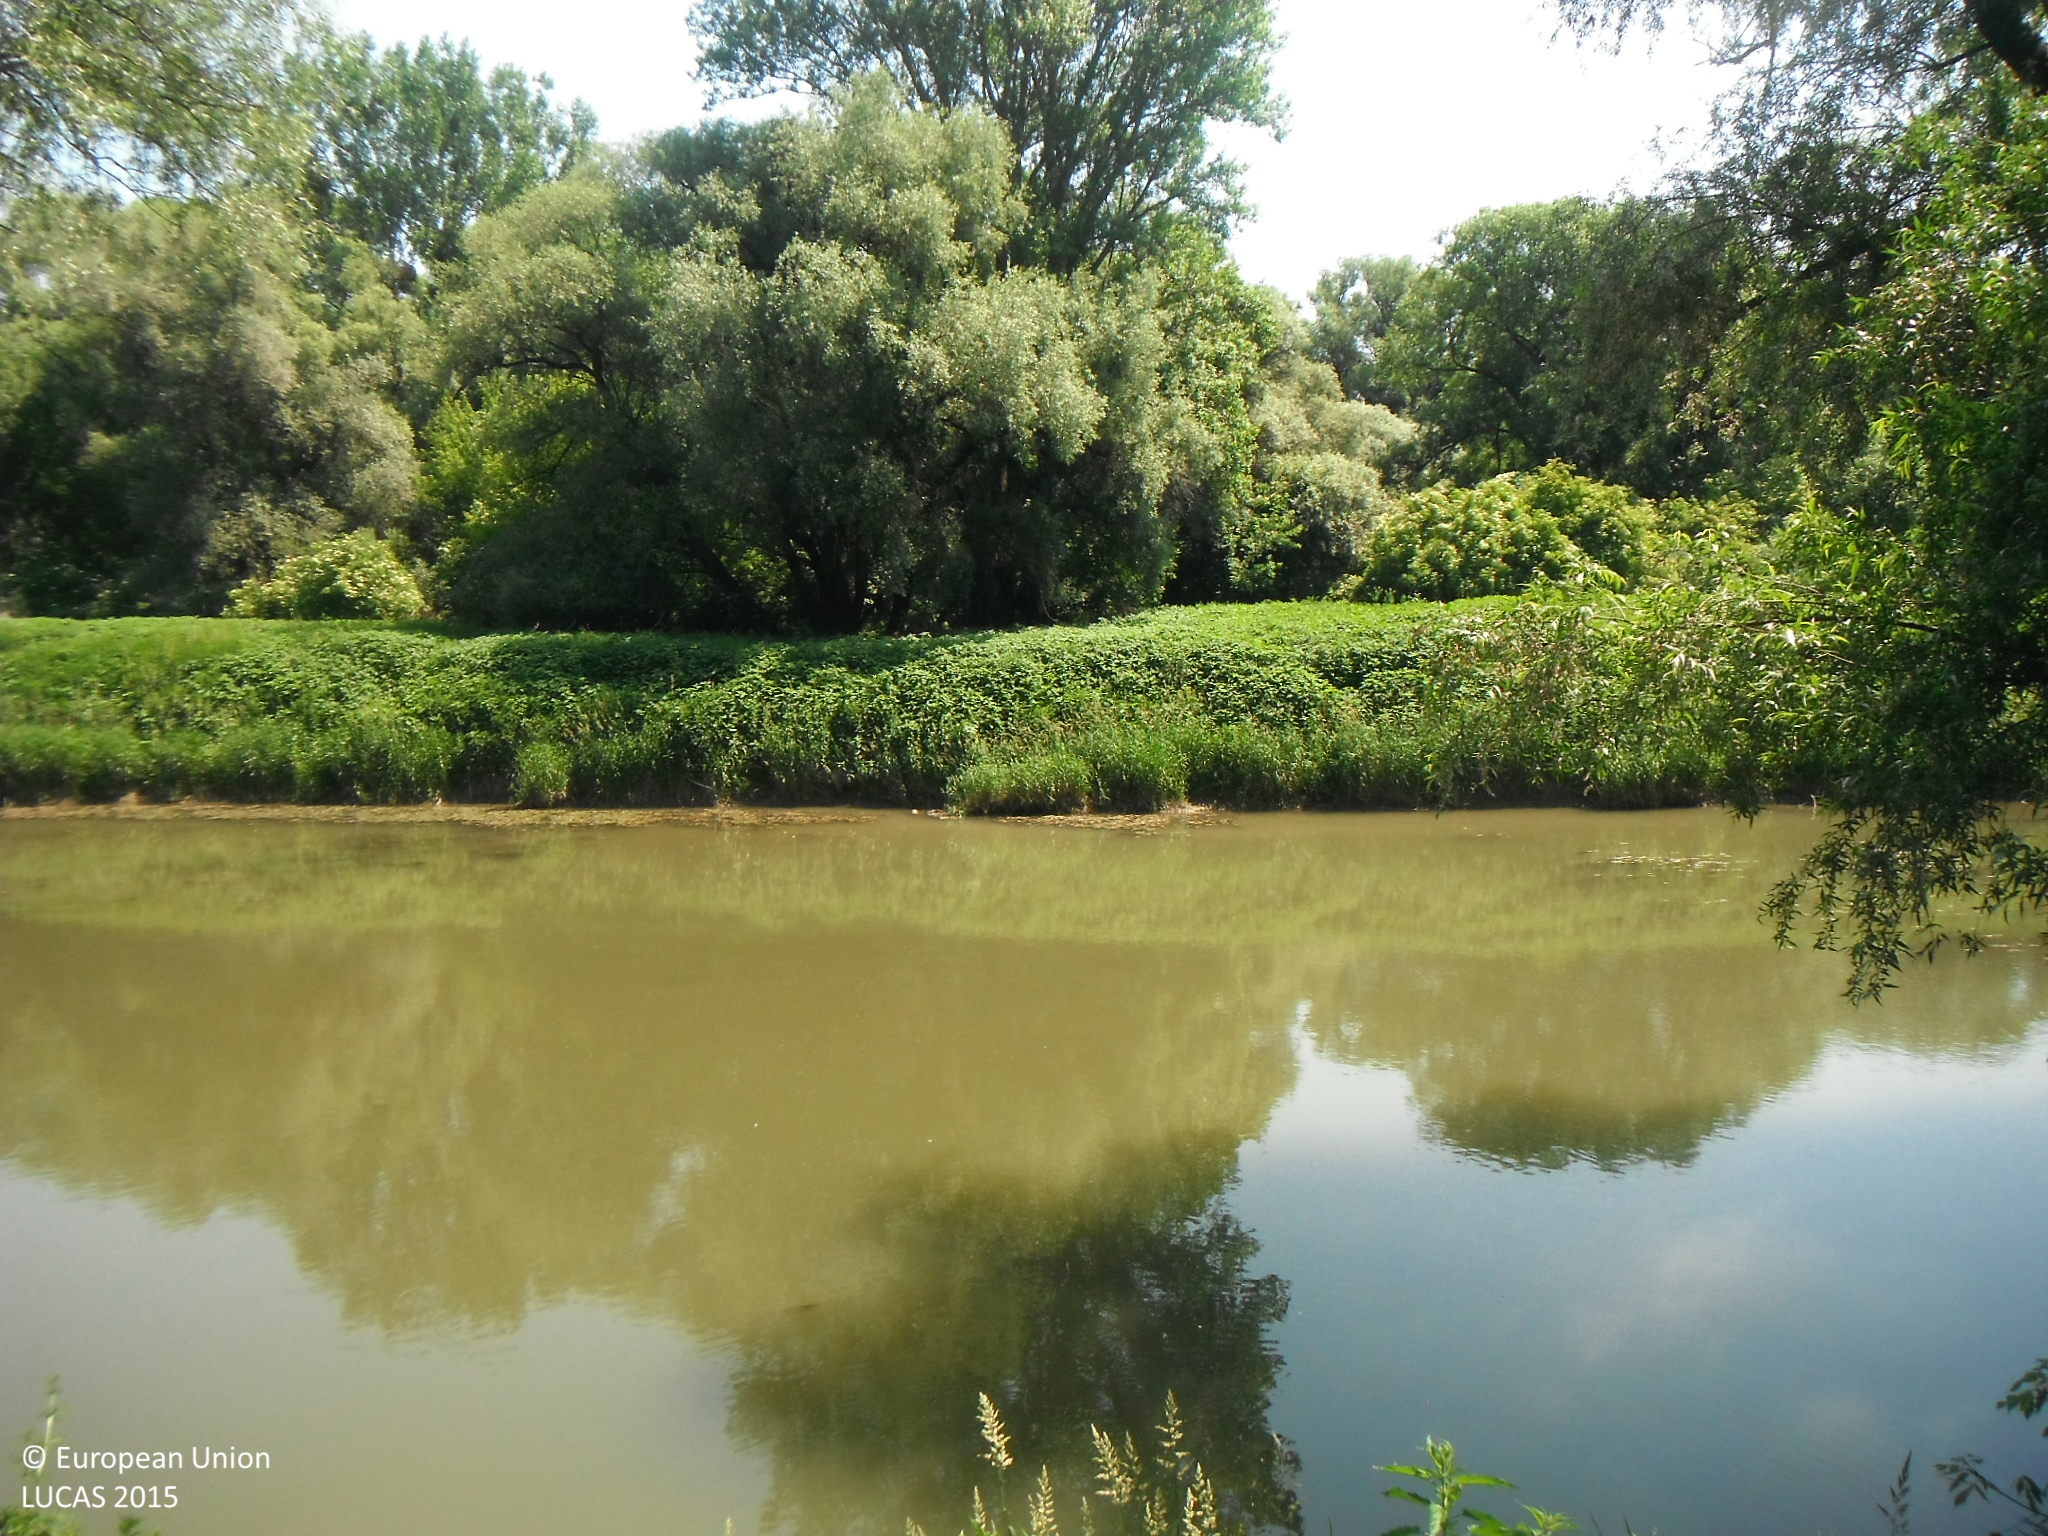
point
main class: Grassland
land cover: Spontaneously vegetated surfaces
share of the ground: > 75 %
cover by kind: herbaceous plants 95 %, shrubs 5 %
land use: Semi-natural and natural areas not in use
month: June
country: SK
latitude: 48.7966
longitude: 21.8833
